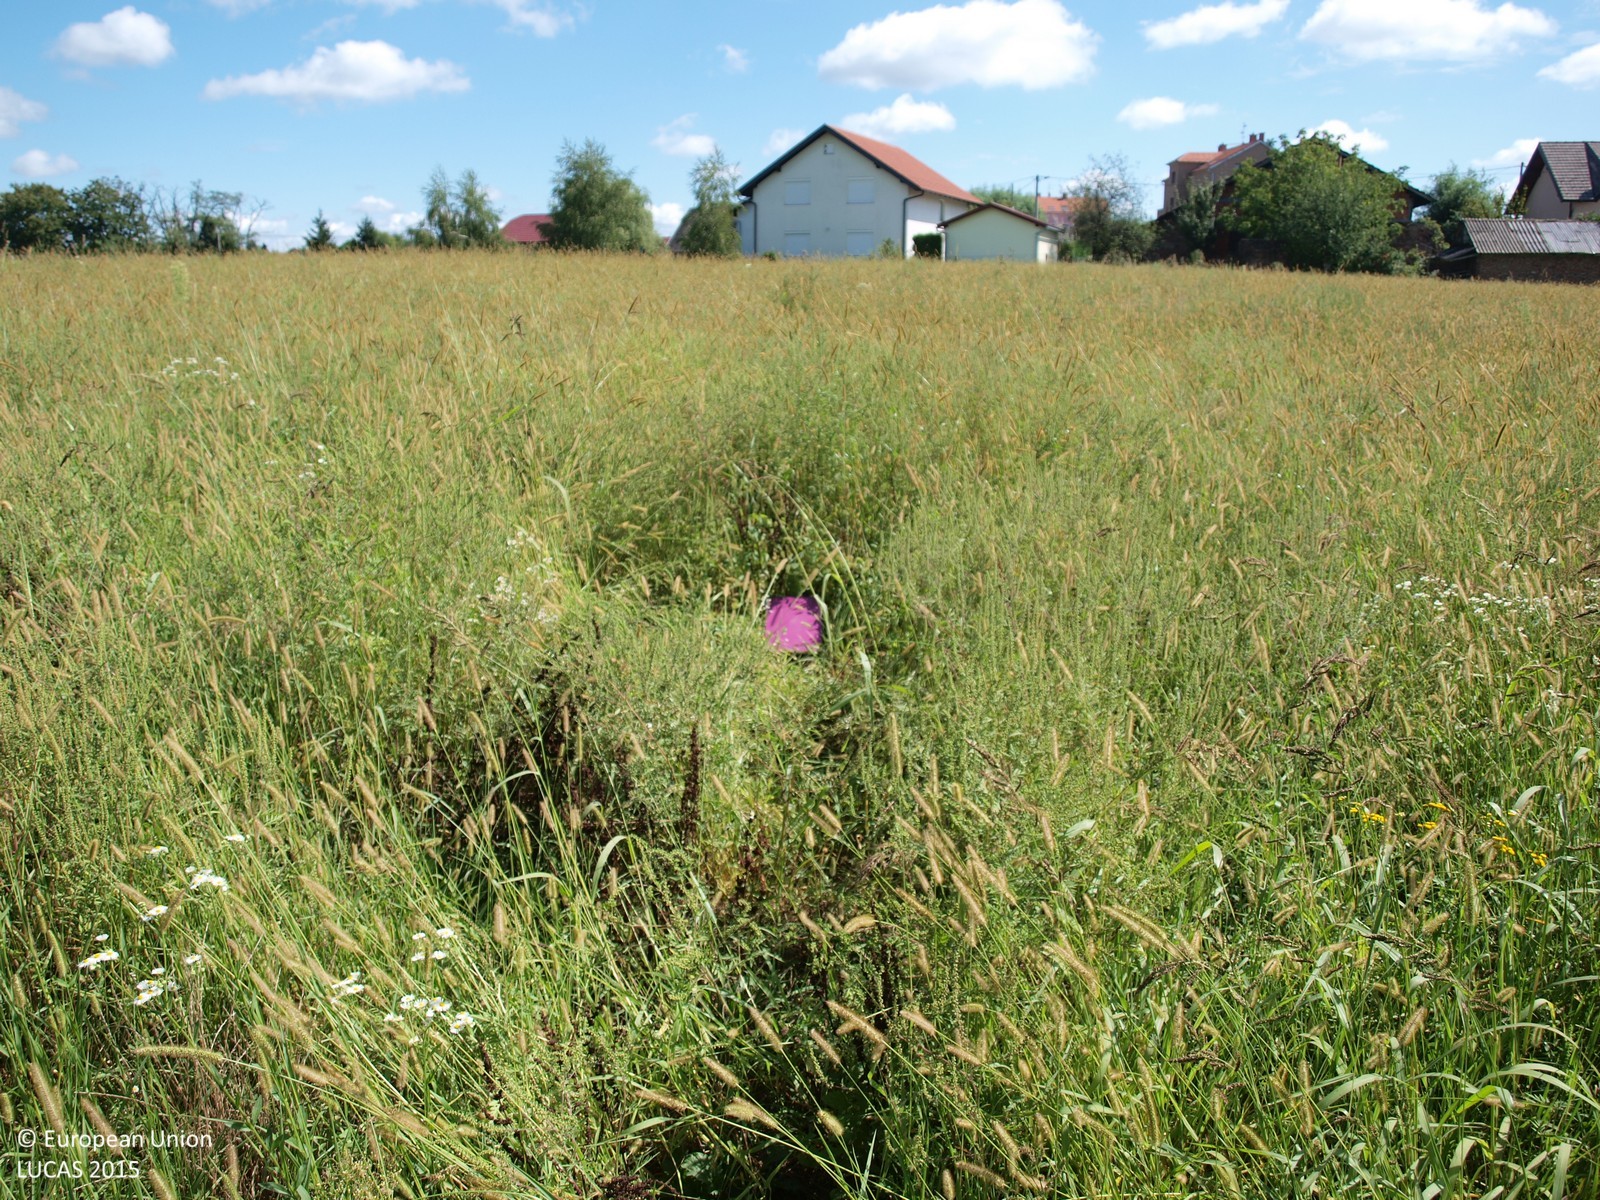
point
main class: Grassland
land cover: Grassland without tree/shrub cover
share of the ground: > 75 %
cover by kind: herbaceous plants 100 %
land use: Agriculture (excluding fallow land and kitchen gardens)
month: September
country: HR
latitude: 45.7432
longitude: 16.4124
